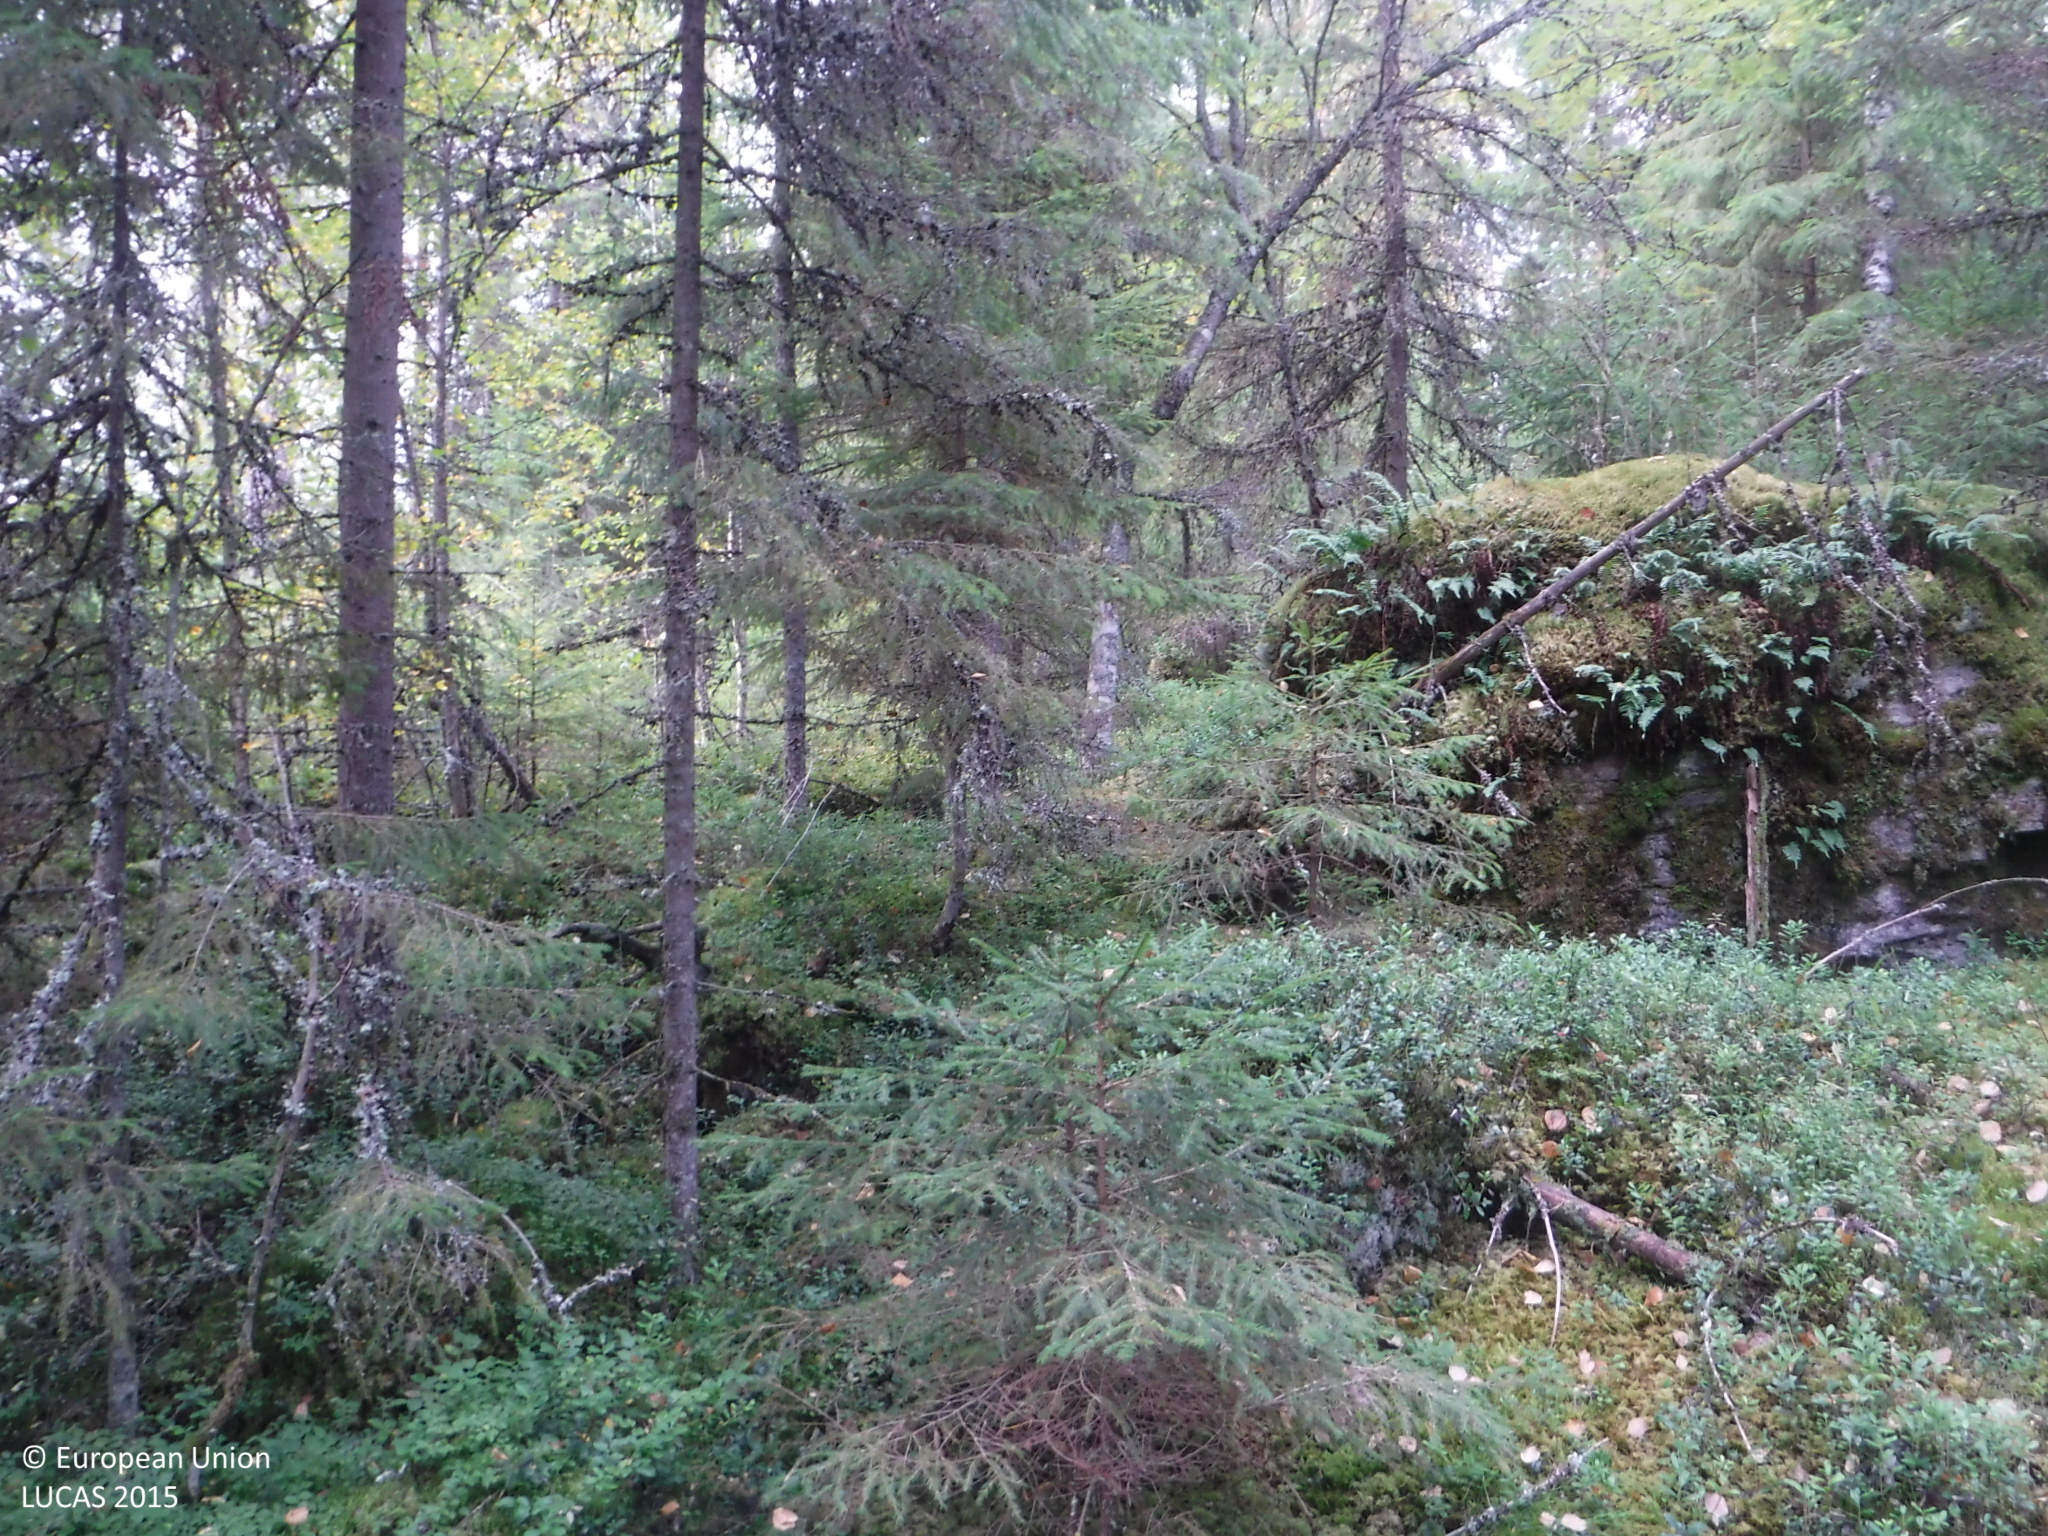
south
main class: Woodland
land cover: Spruce dominated mixed woodland
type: boreal forest
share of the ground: 50 - 75 %
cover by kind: coniferous forest trees 35 %, shrubs 25 %, lichens and mosses 25 %, broadleaved forest trees 15 %
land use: Forestry
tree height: > 5 m
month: September
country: FI
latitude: 61.7343
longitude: 22.1527
